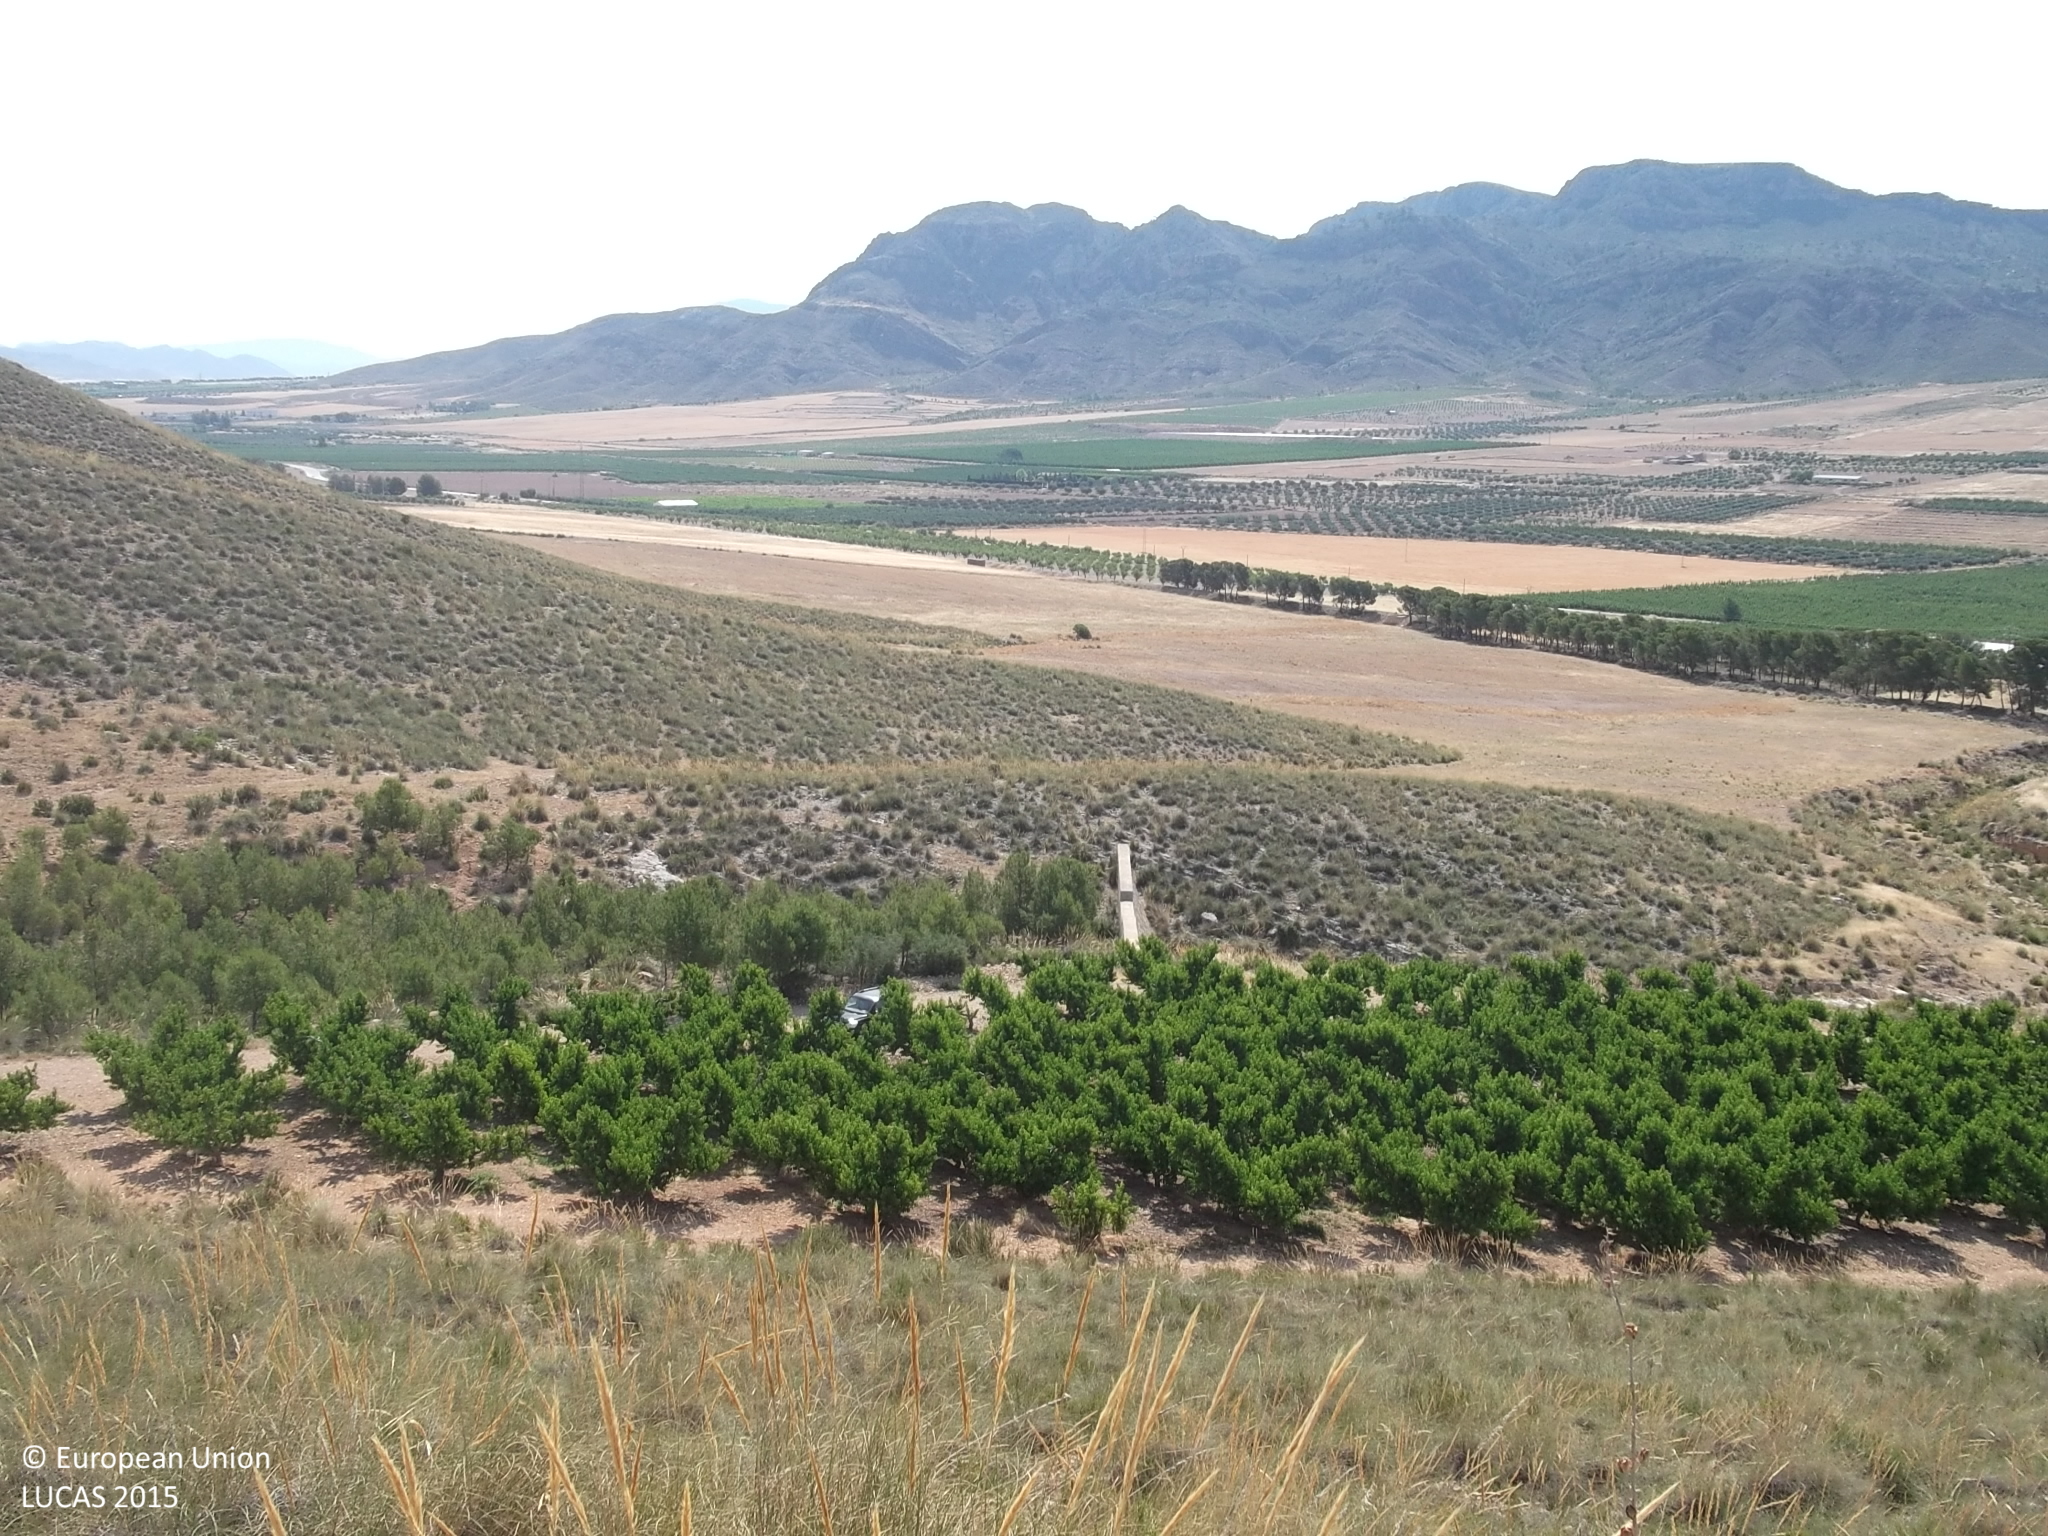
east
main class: Shrubland
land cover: Shrubland without tree cover
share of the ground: 25 - 50 %
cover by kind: shrubs 40 %, herbaceous plants 30 %, consolidated bare surface 30 %
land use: Semi-natural and natural areas not in use
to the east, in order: Shrubland without tree cover; Tracks; Other fruit trees and berries; Tracks; Pine dominated coniferous woodland; Shrubland without tree cover; Tracks; Shrubland without tree cover
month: June
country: ES
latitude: 38.4354
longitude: -1.3664
